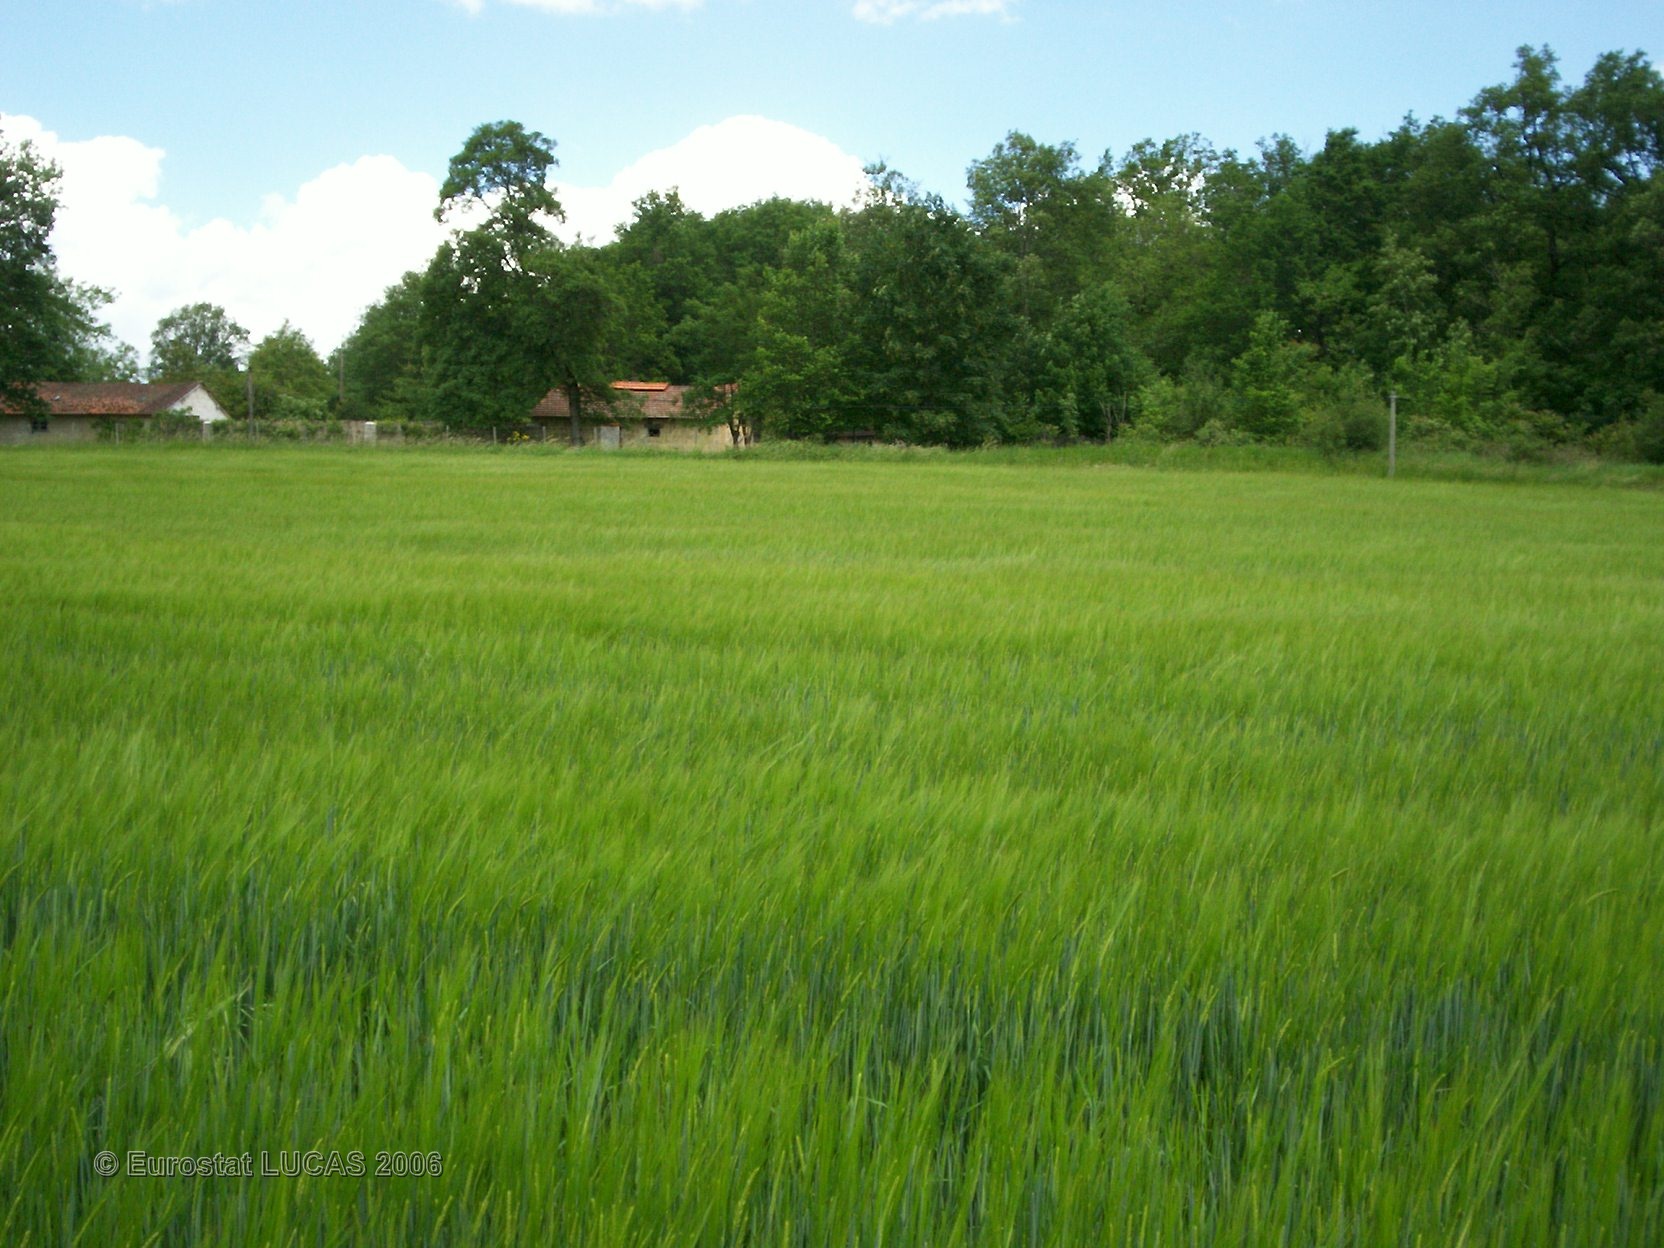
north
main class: Cropland
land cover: Barley
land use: Agriculture (excluding fallow land and kitchen gardens)
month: May
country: FR
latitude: 45.2988
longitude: 0.7700
